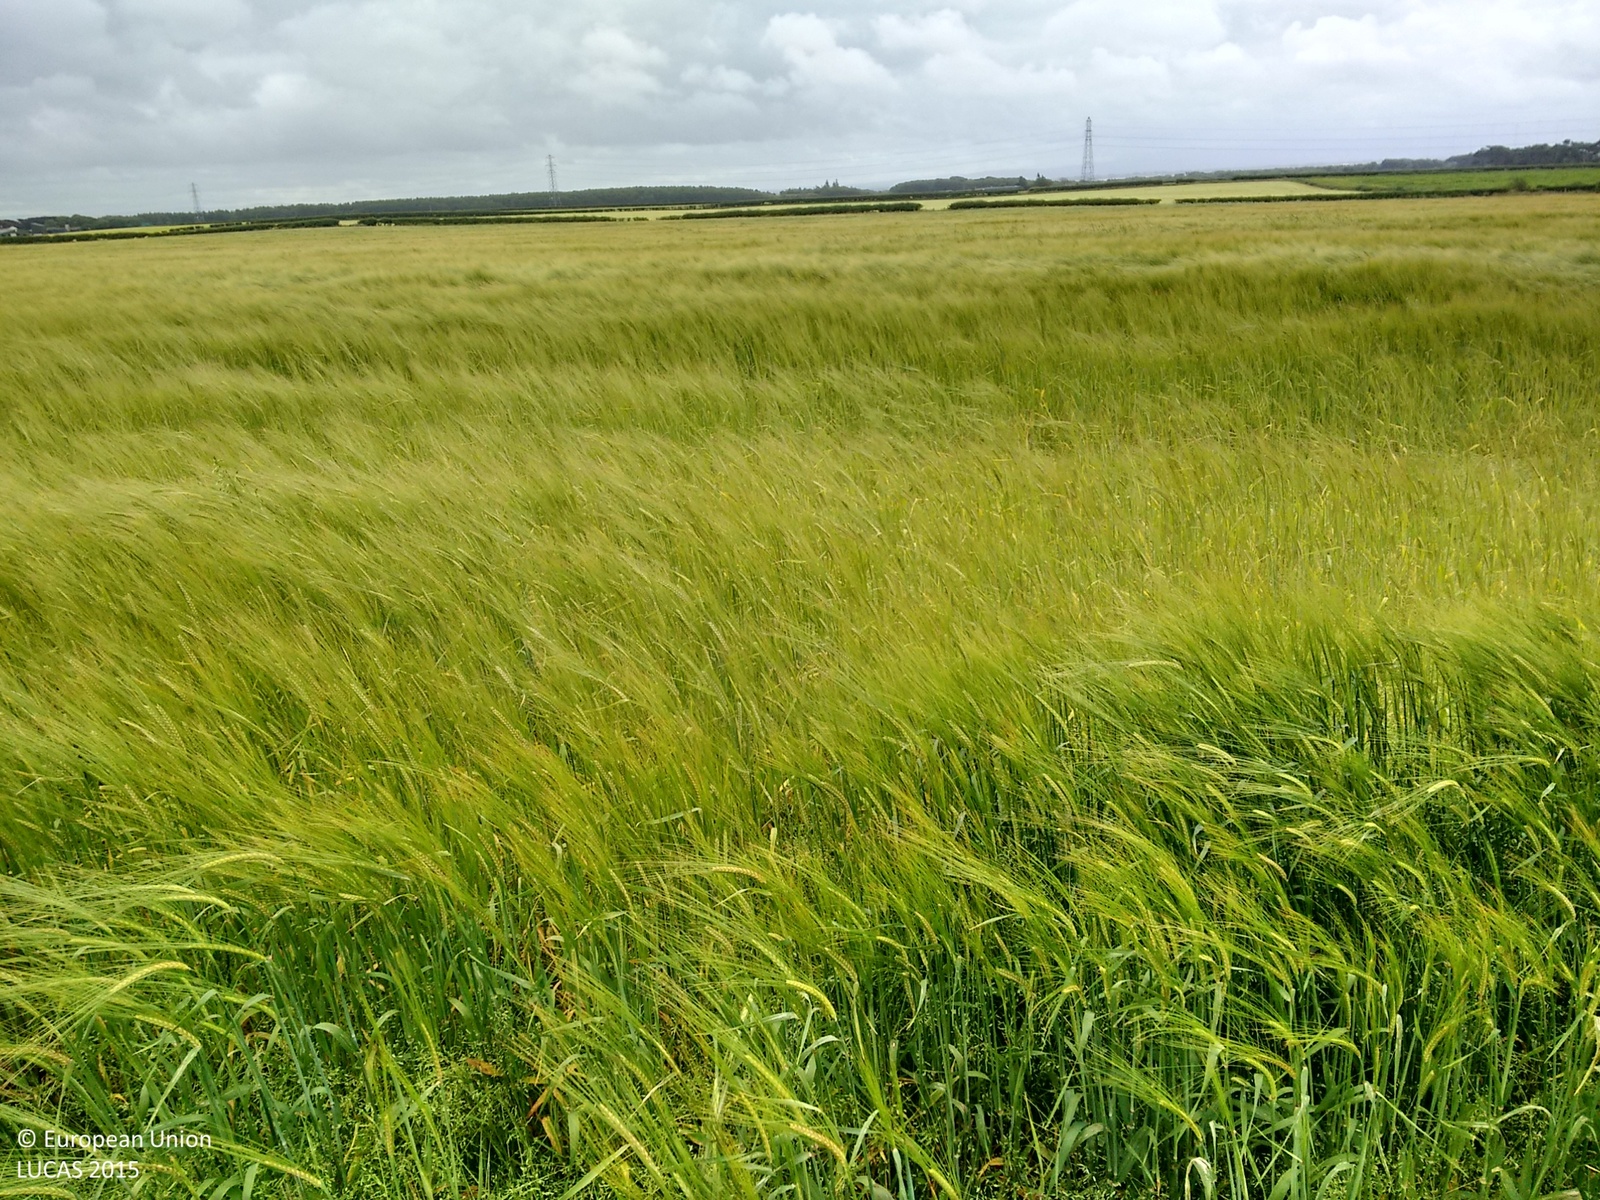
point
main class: Cropland
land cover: Barley
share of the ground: > 75 %
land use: Agriculture (excluding fallow land and kitchen gardens)
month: July
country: GB
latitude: 54.9968
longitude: -3.3172
